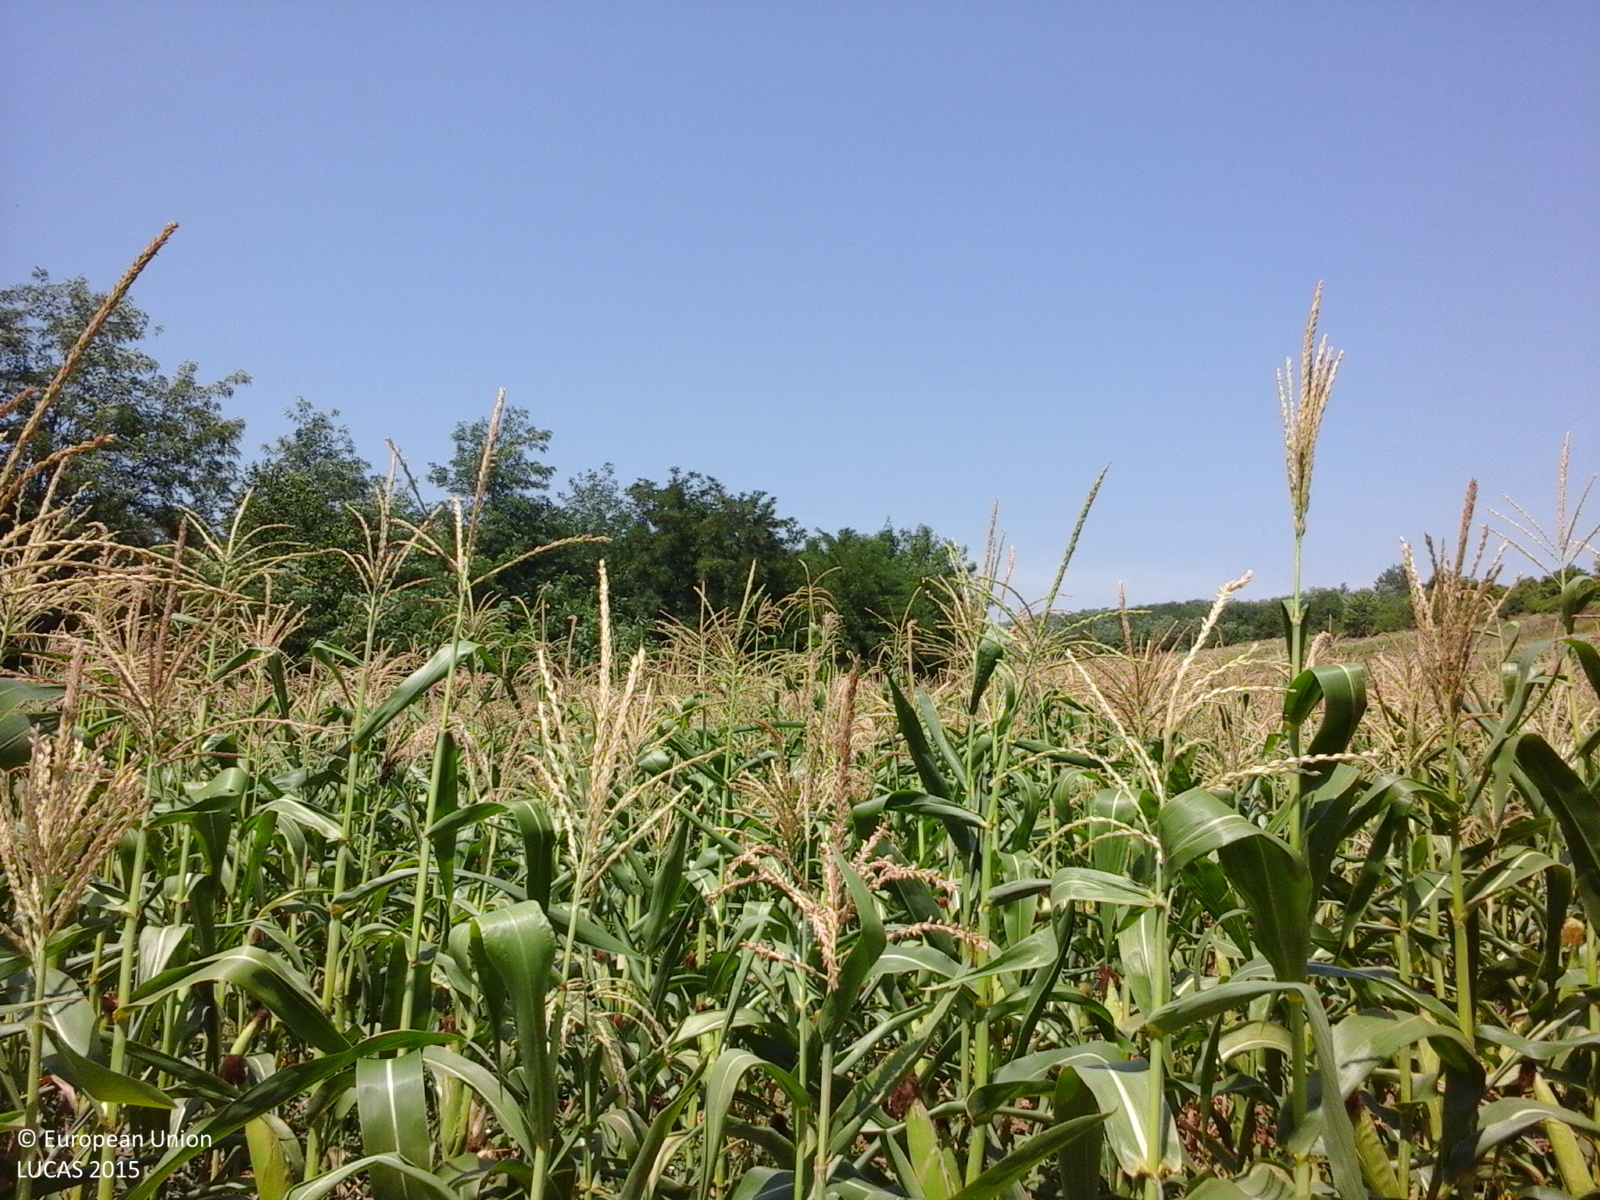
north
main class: Cropland
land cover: Maize
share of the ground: > 75 %
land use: Agriculture (excluding fallow land and kitchen gardens)
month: July
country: RO
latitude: 46.2585
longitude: 27.2650
